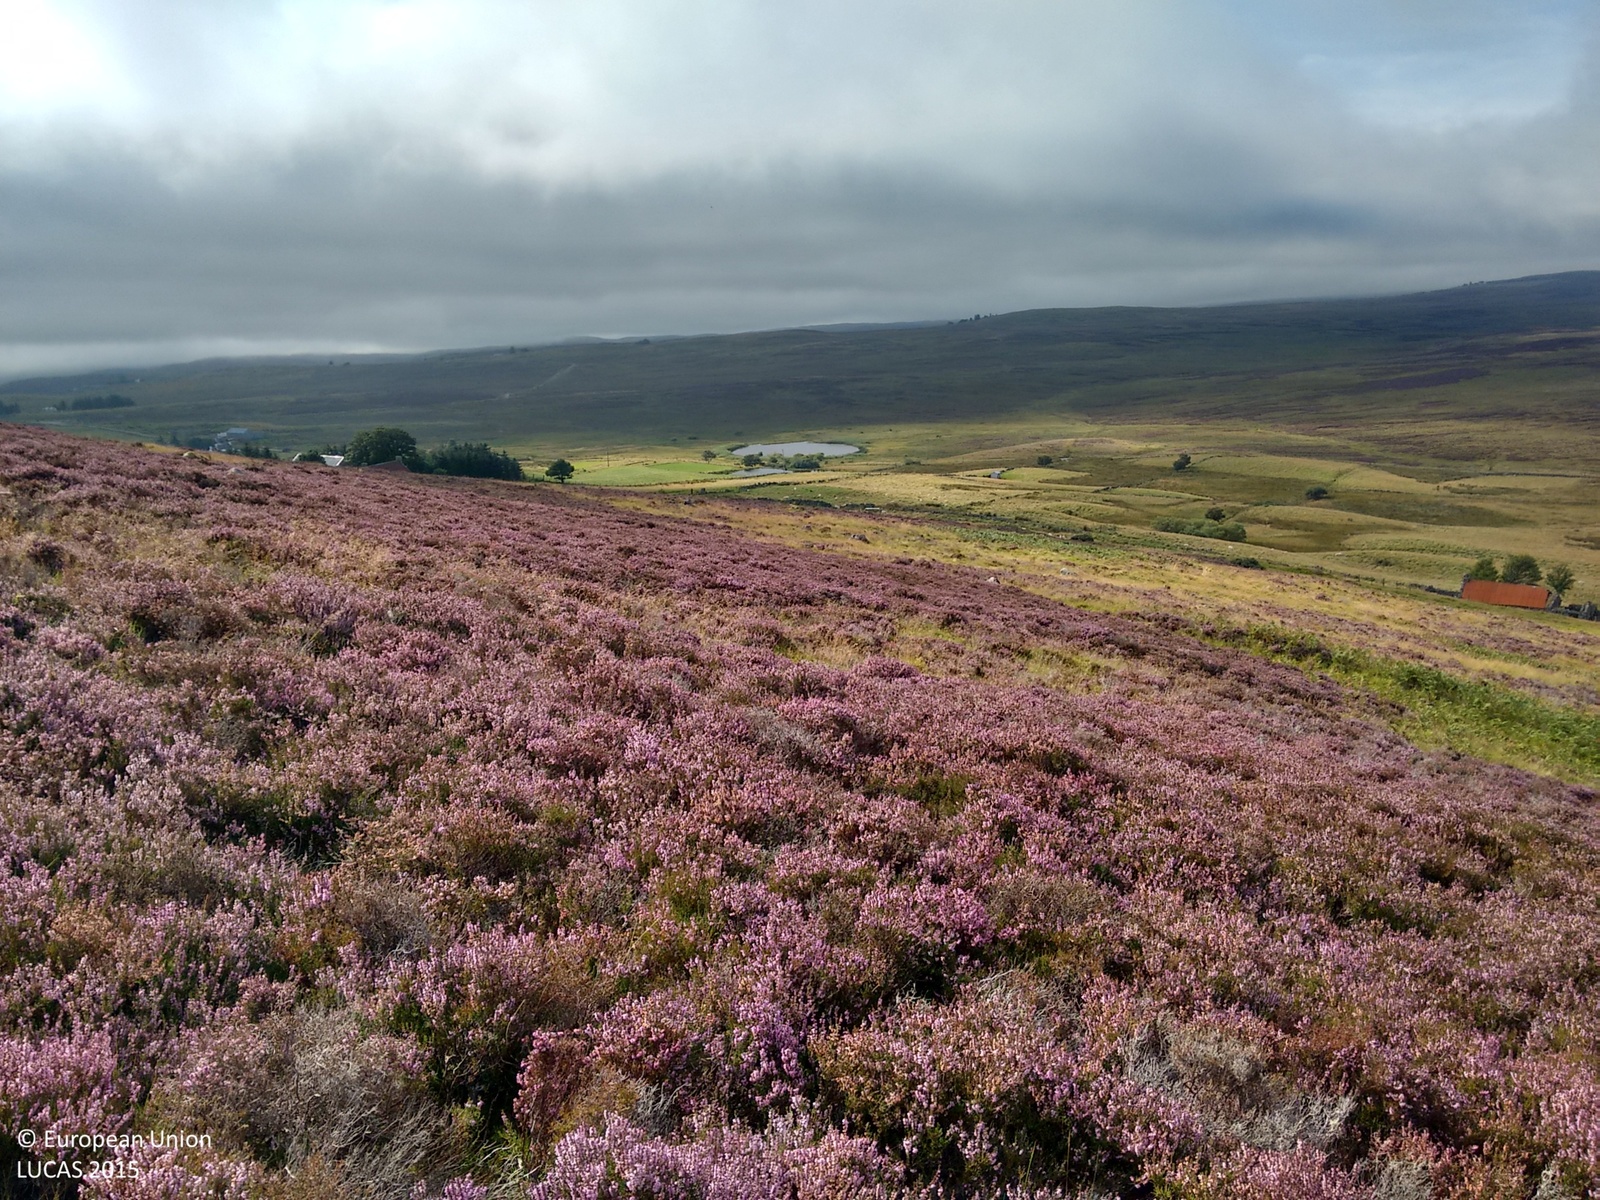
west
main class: Shrubland
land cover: Shrubland without tree cover
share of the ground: > 75 %
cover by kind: shrubs 100 %
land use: Agriculture (excluding fallow land and kitchen gardens)
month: September
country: GB
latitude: 58.0363
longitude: -4.1200
